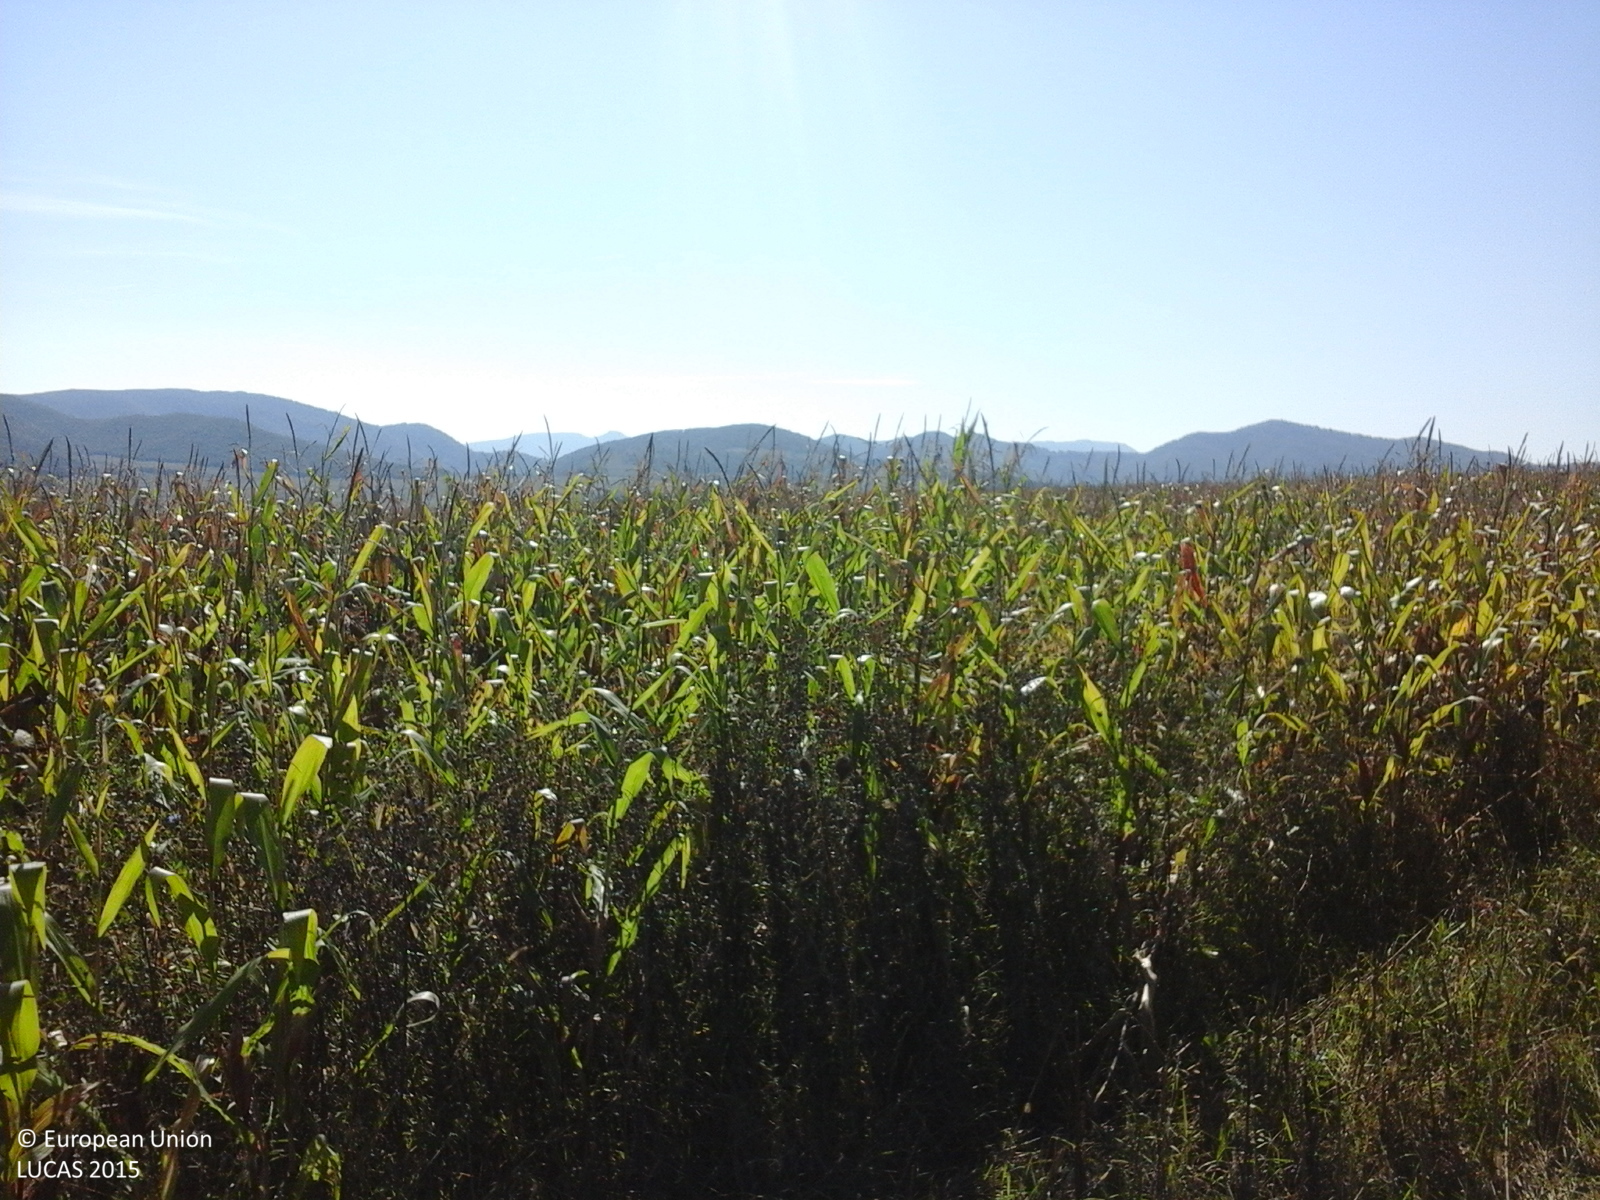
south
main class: Cropland
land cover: Maize
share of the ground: > 75 %
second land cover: Spontaneously vegetated surfaces
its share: 10 - 25 %
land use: Agriculture (excluding fallow land and kitchen gardens)
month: October
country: RO
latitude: 46.5762
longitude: 23.5747
